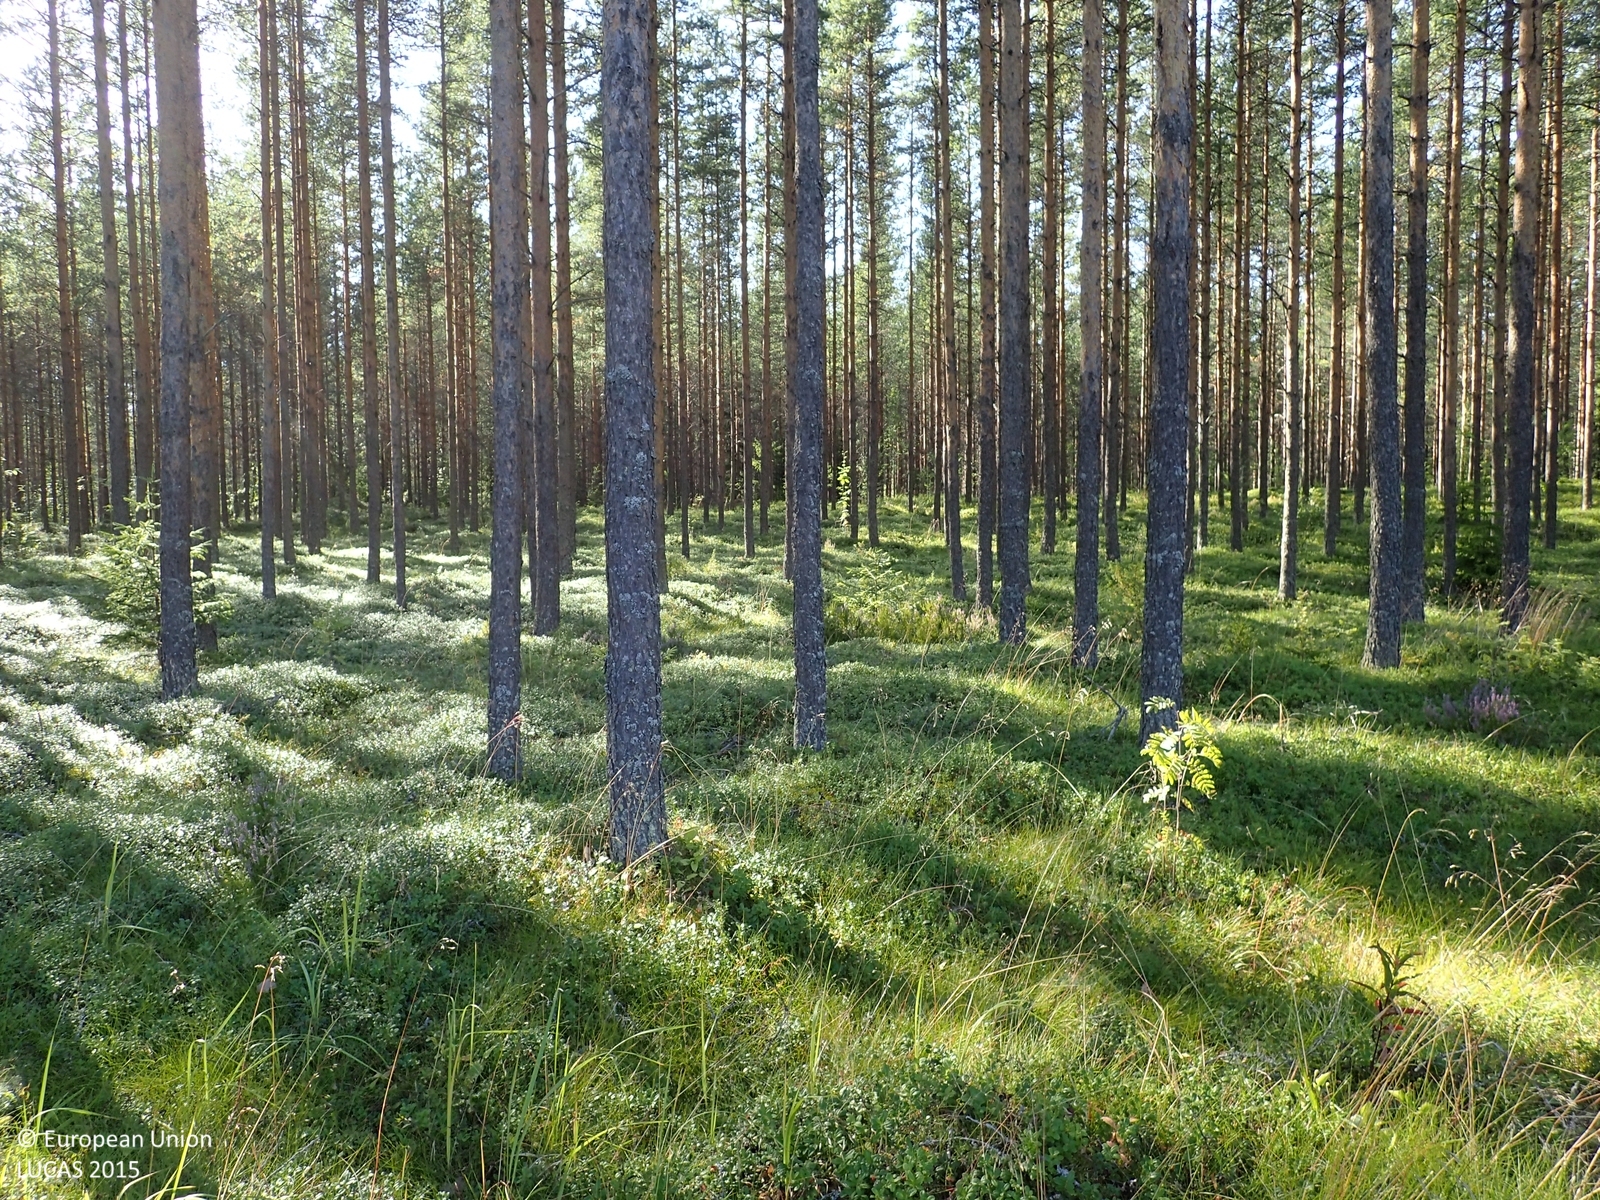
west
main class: Woodland
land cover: Pine dominated coniferous woodland
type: boreal forest
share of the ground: > 75 %
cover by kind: coniferous forest trees 75 %, shrubs 20 %, herbaceous plants 5 %
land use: Forestry
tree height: > 5 m
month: August
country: FI
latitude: 62.4384
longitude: 21.8065
